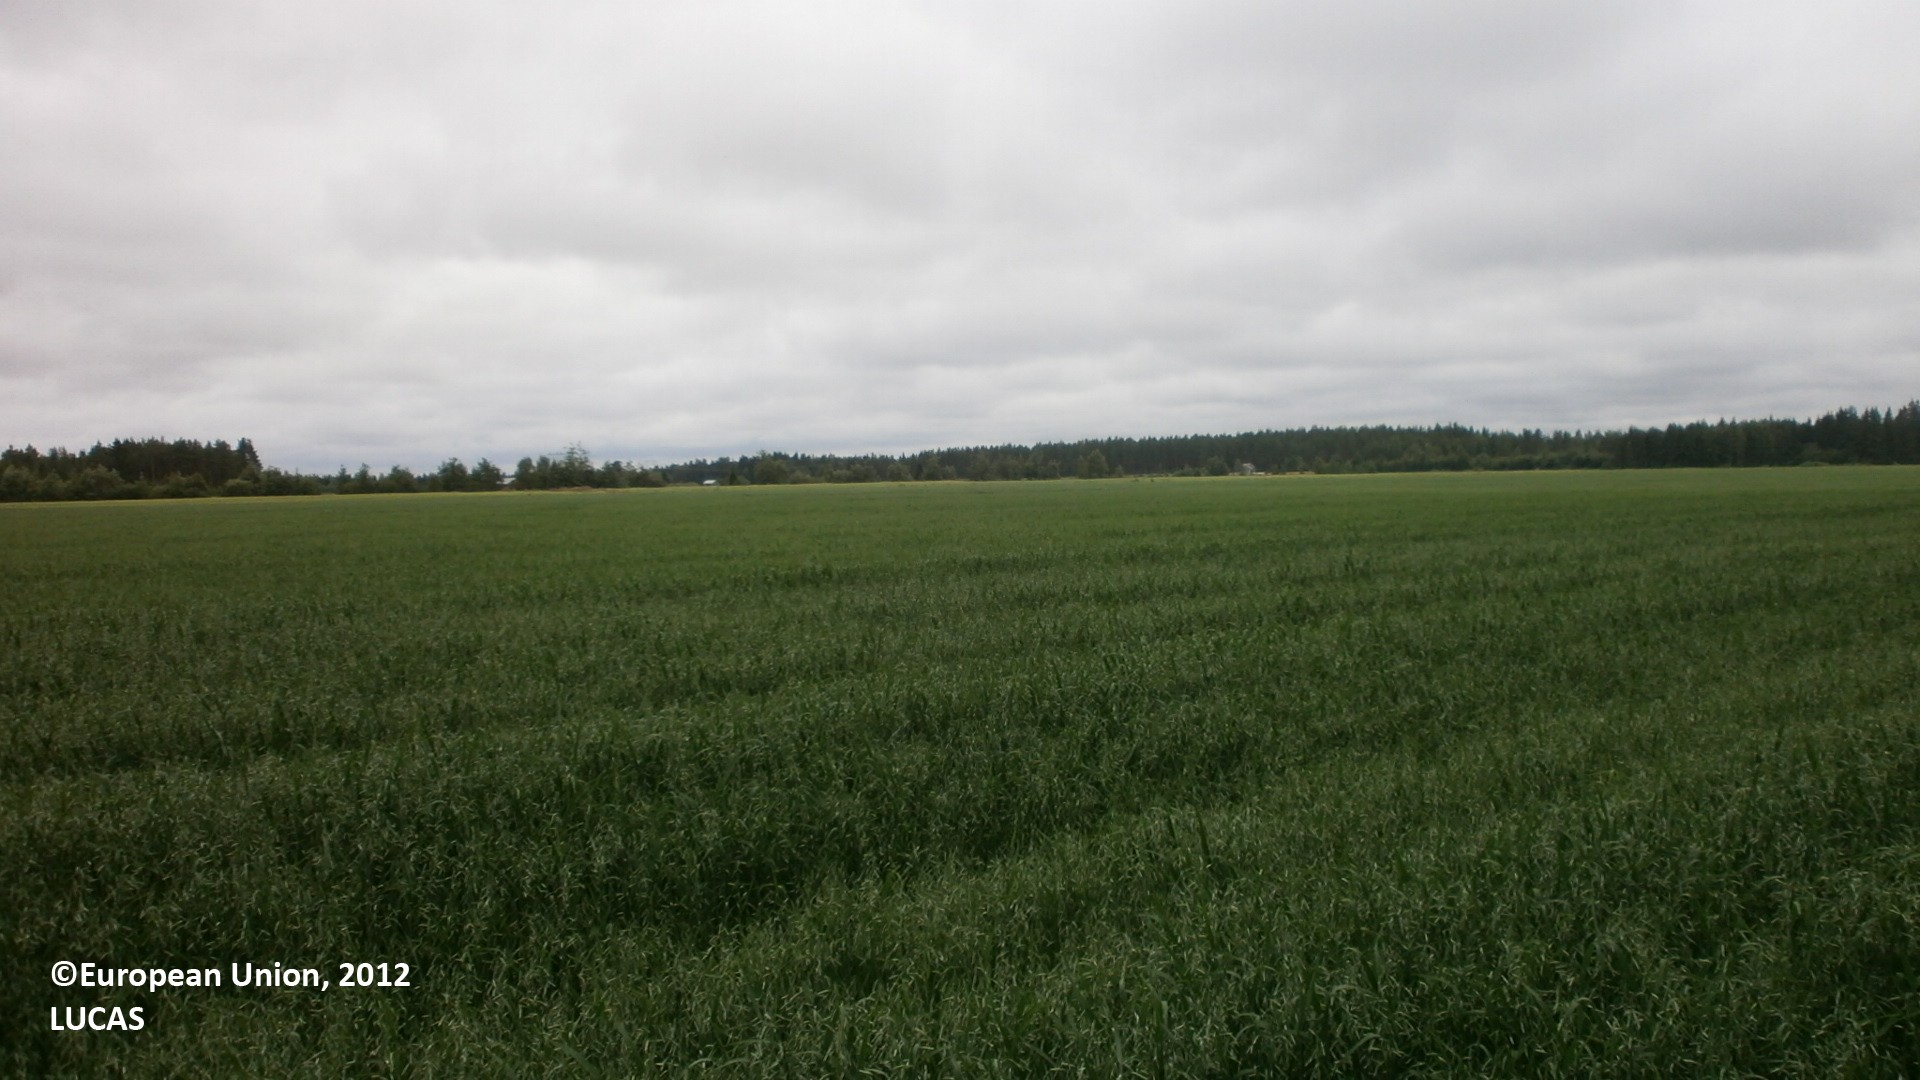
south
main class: Cropland
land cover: Oats
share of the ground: > 75 %
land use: Agriculture (excluding fallow land and kitchen gardens)
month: July
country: FI
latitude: 64.2422
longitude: 24.1101
